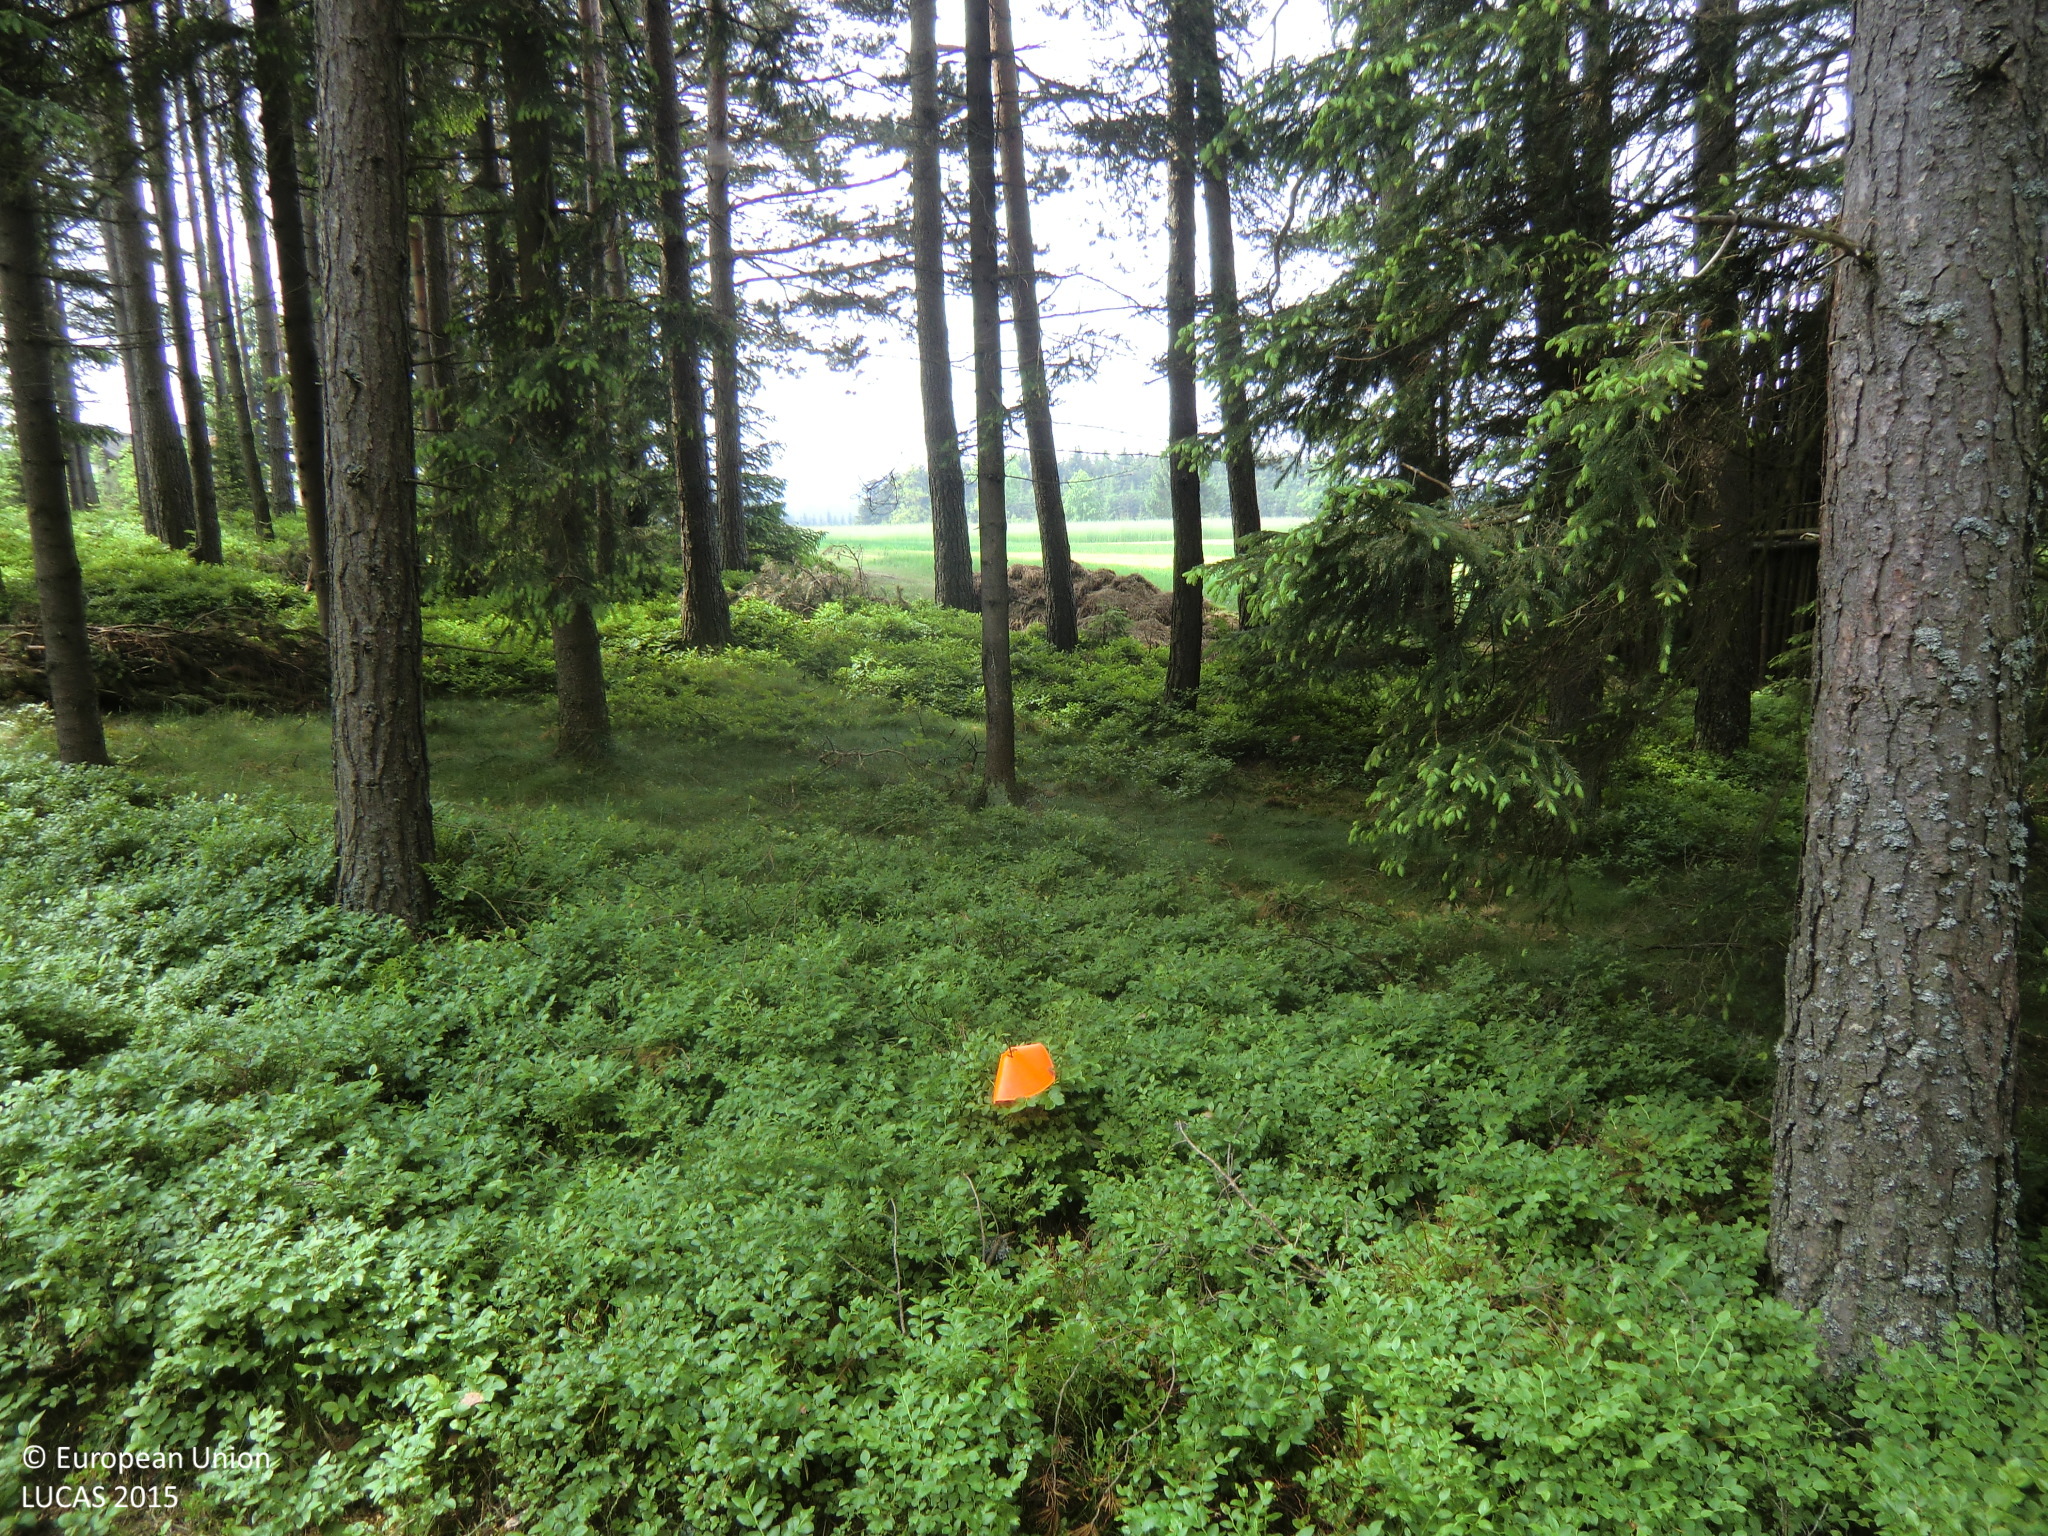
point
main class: Woodland
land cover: Pine dominated coniferous woodland
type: hemiboreal forest and nemoral coniferous forest and mixed broadleaved-coniferous forest
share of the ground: > 75 %
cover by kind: coniferous forest trees 80 %, shrubs 20 %
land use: Forestry
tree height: > 5 m
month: June
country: AT
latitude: 48.6062
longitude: 14.7887
